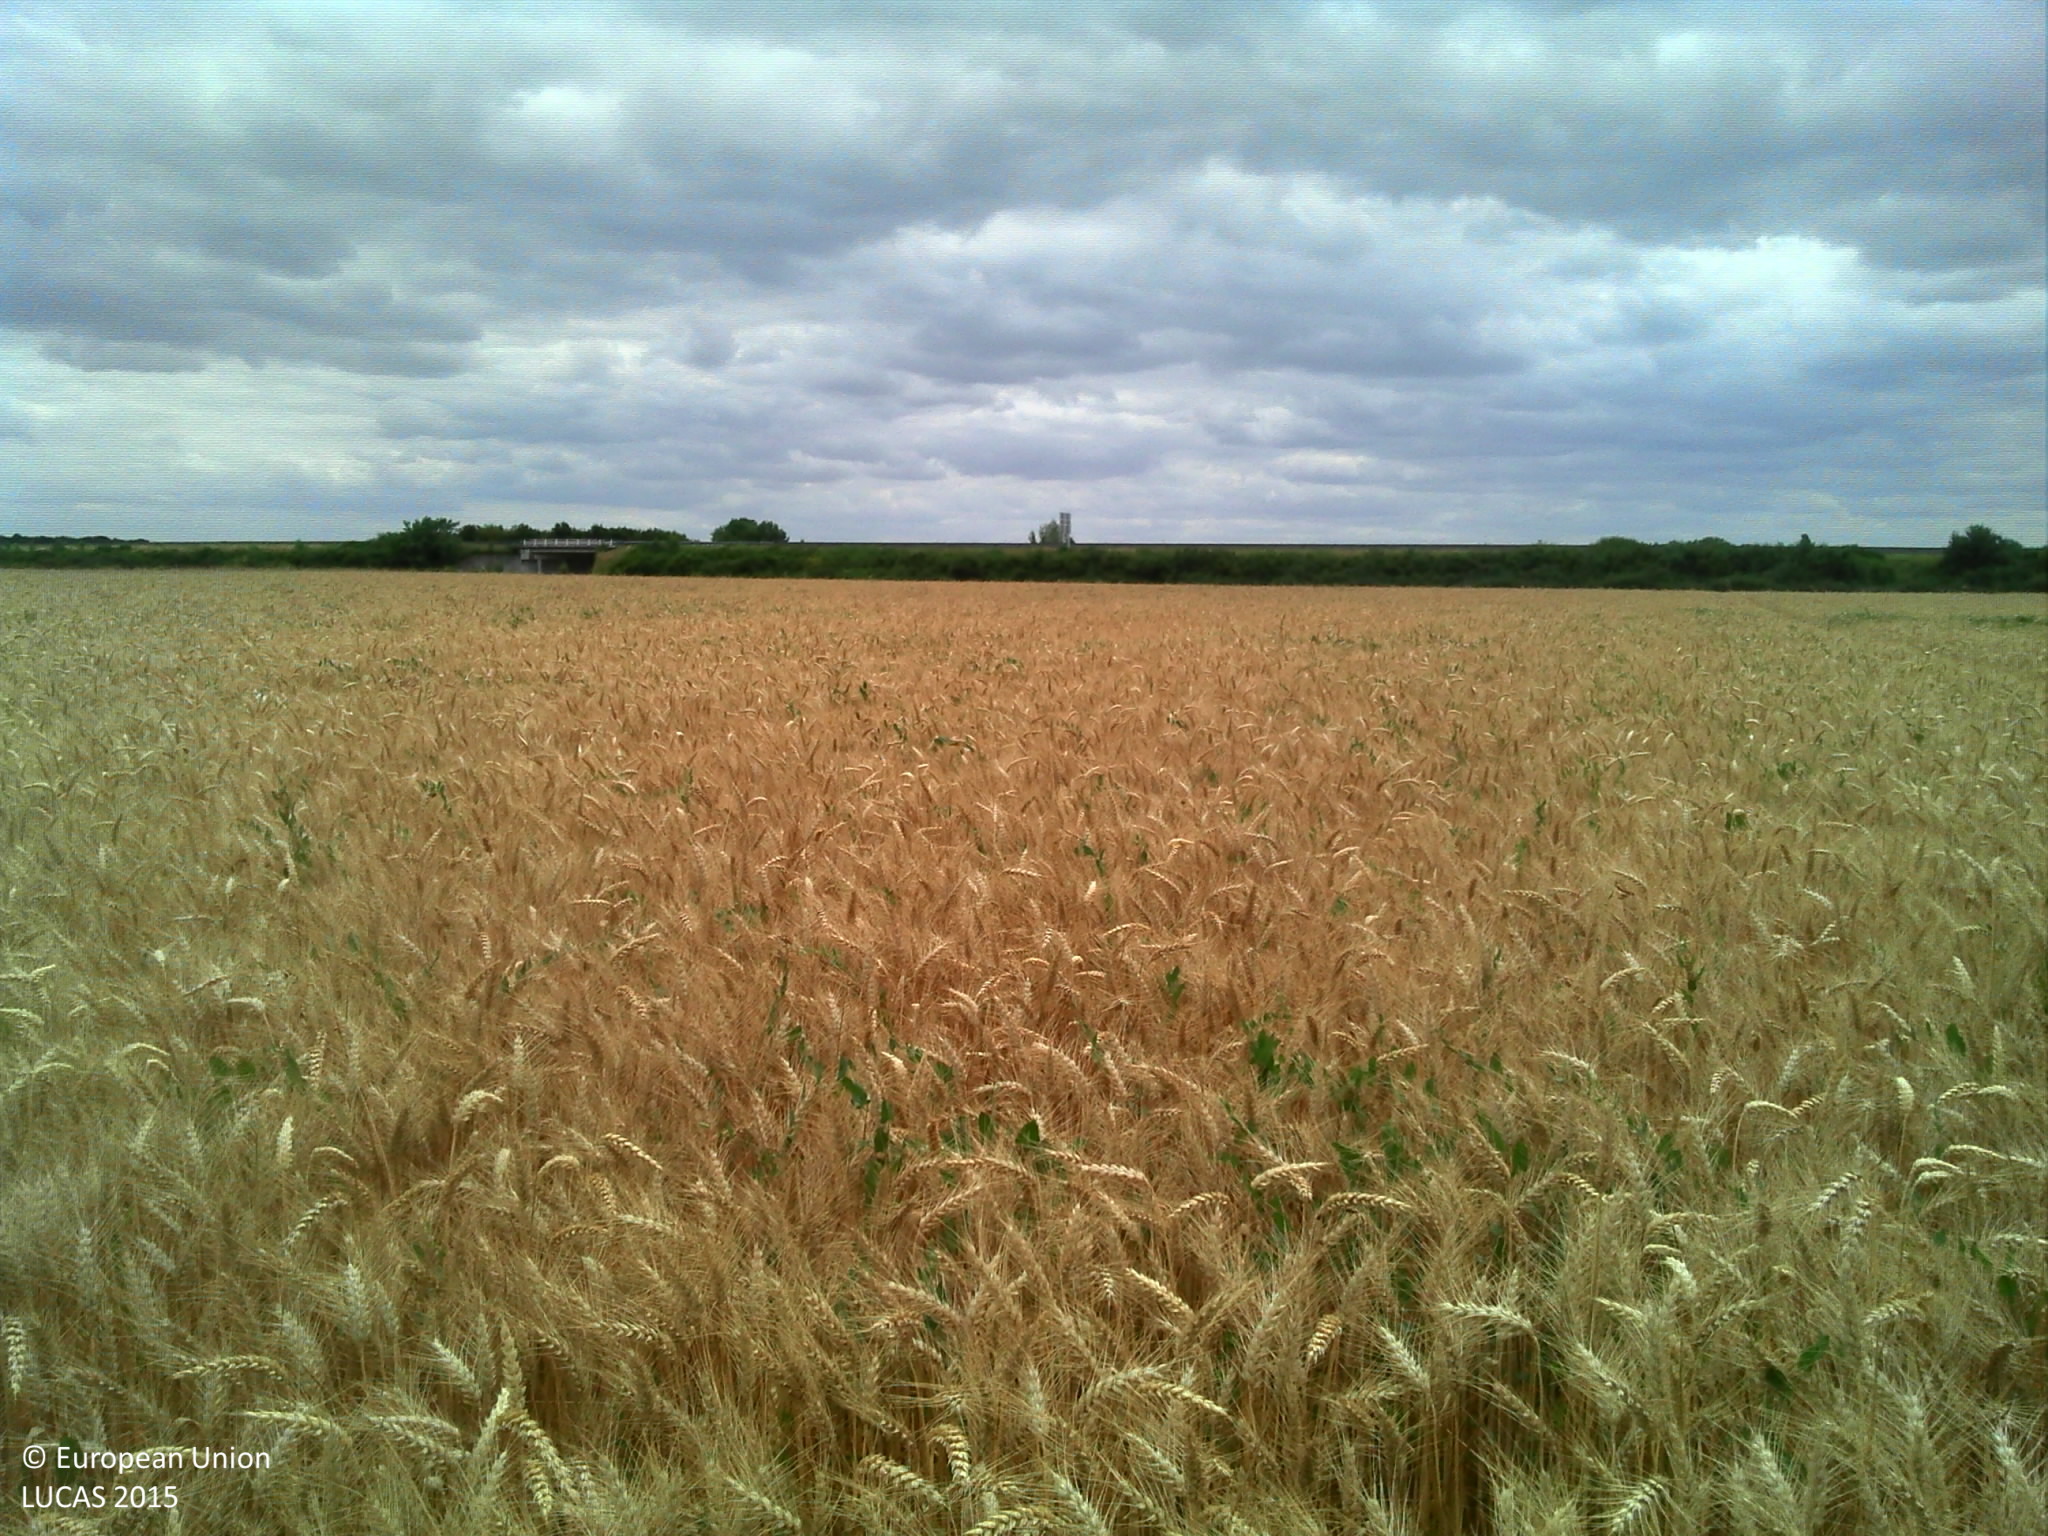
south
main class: Cropland
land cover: Common wheat
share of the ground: > 75 %
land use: Agriculture (excluding fallow land and kitchen gardens)
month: July
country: FR
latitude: 47.3070
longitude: 0.5222
